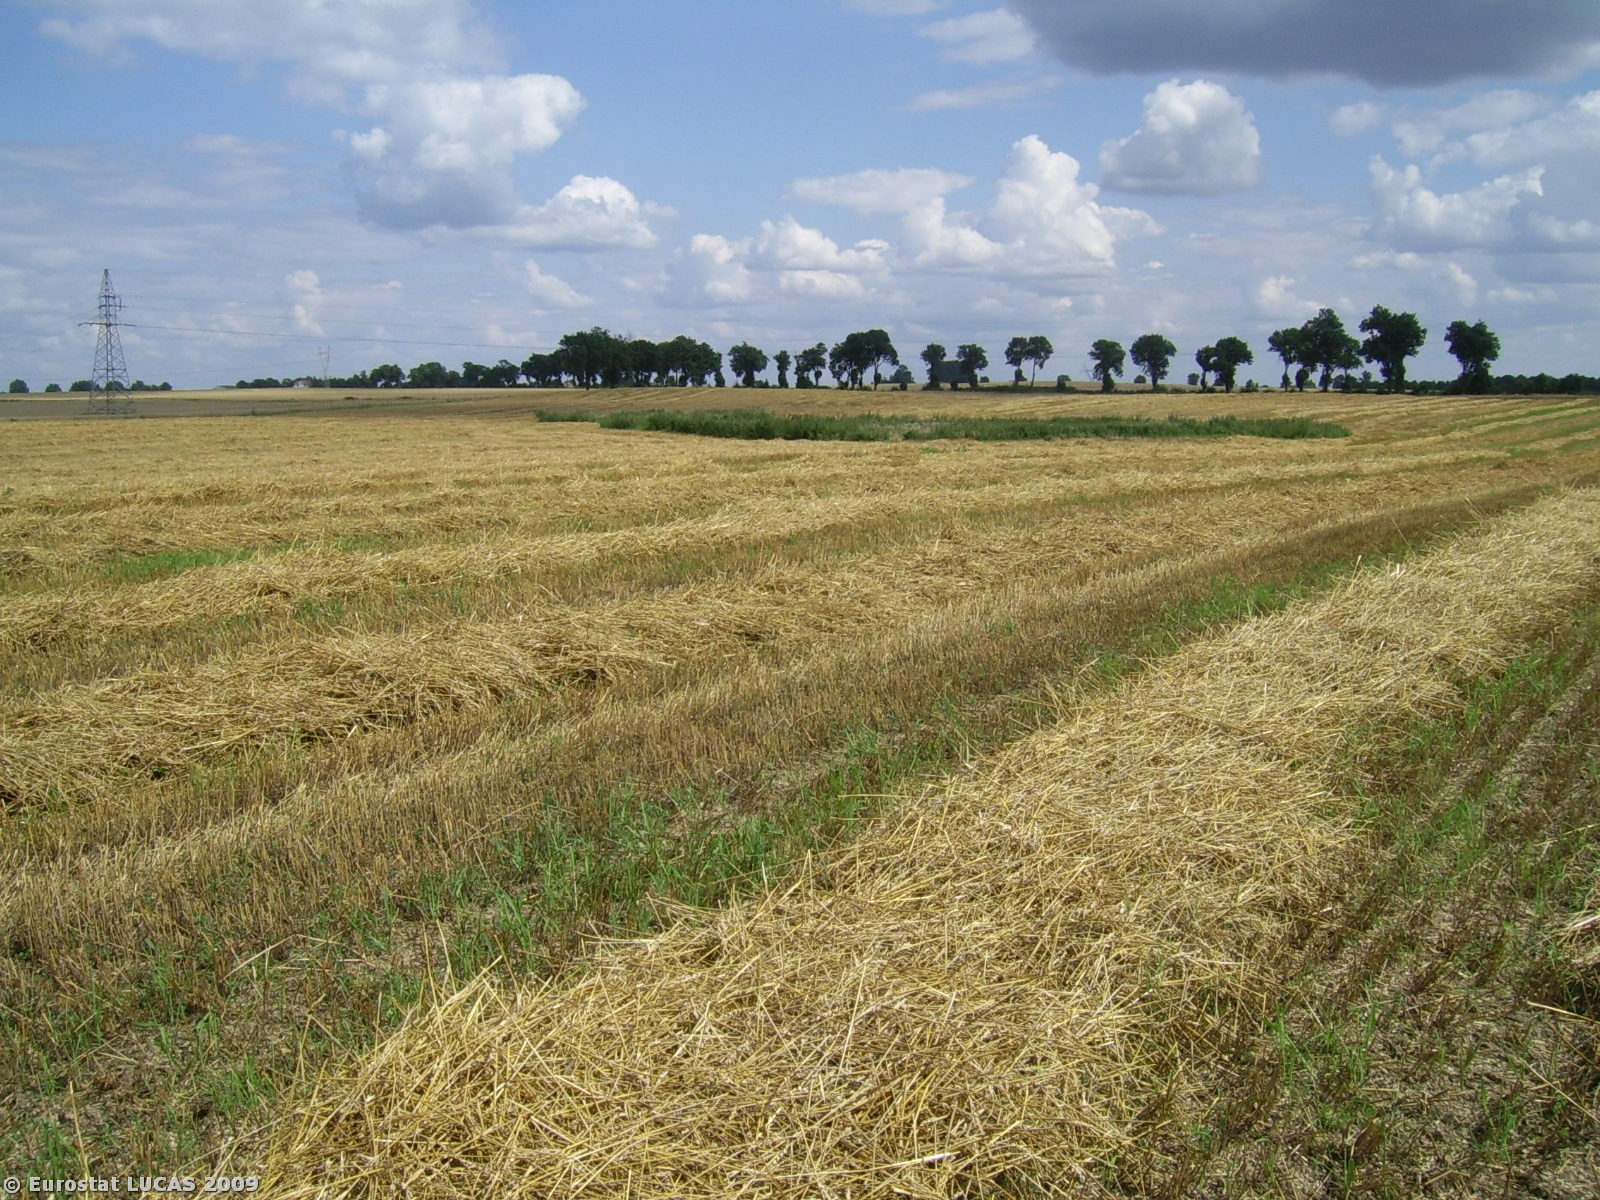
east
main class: Cropland
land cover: Common wheat
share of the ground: > 75 %
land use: Agriculture (excluding fallow land and kitchen gardens)
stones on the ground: < 10 %
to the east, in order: Common wheat; Grassland without tree/shrub cover; Common wheat
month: August
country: PL
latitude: 53.0488
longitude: 18.7473
